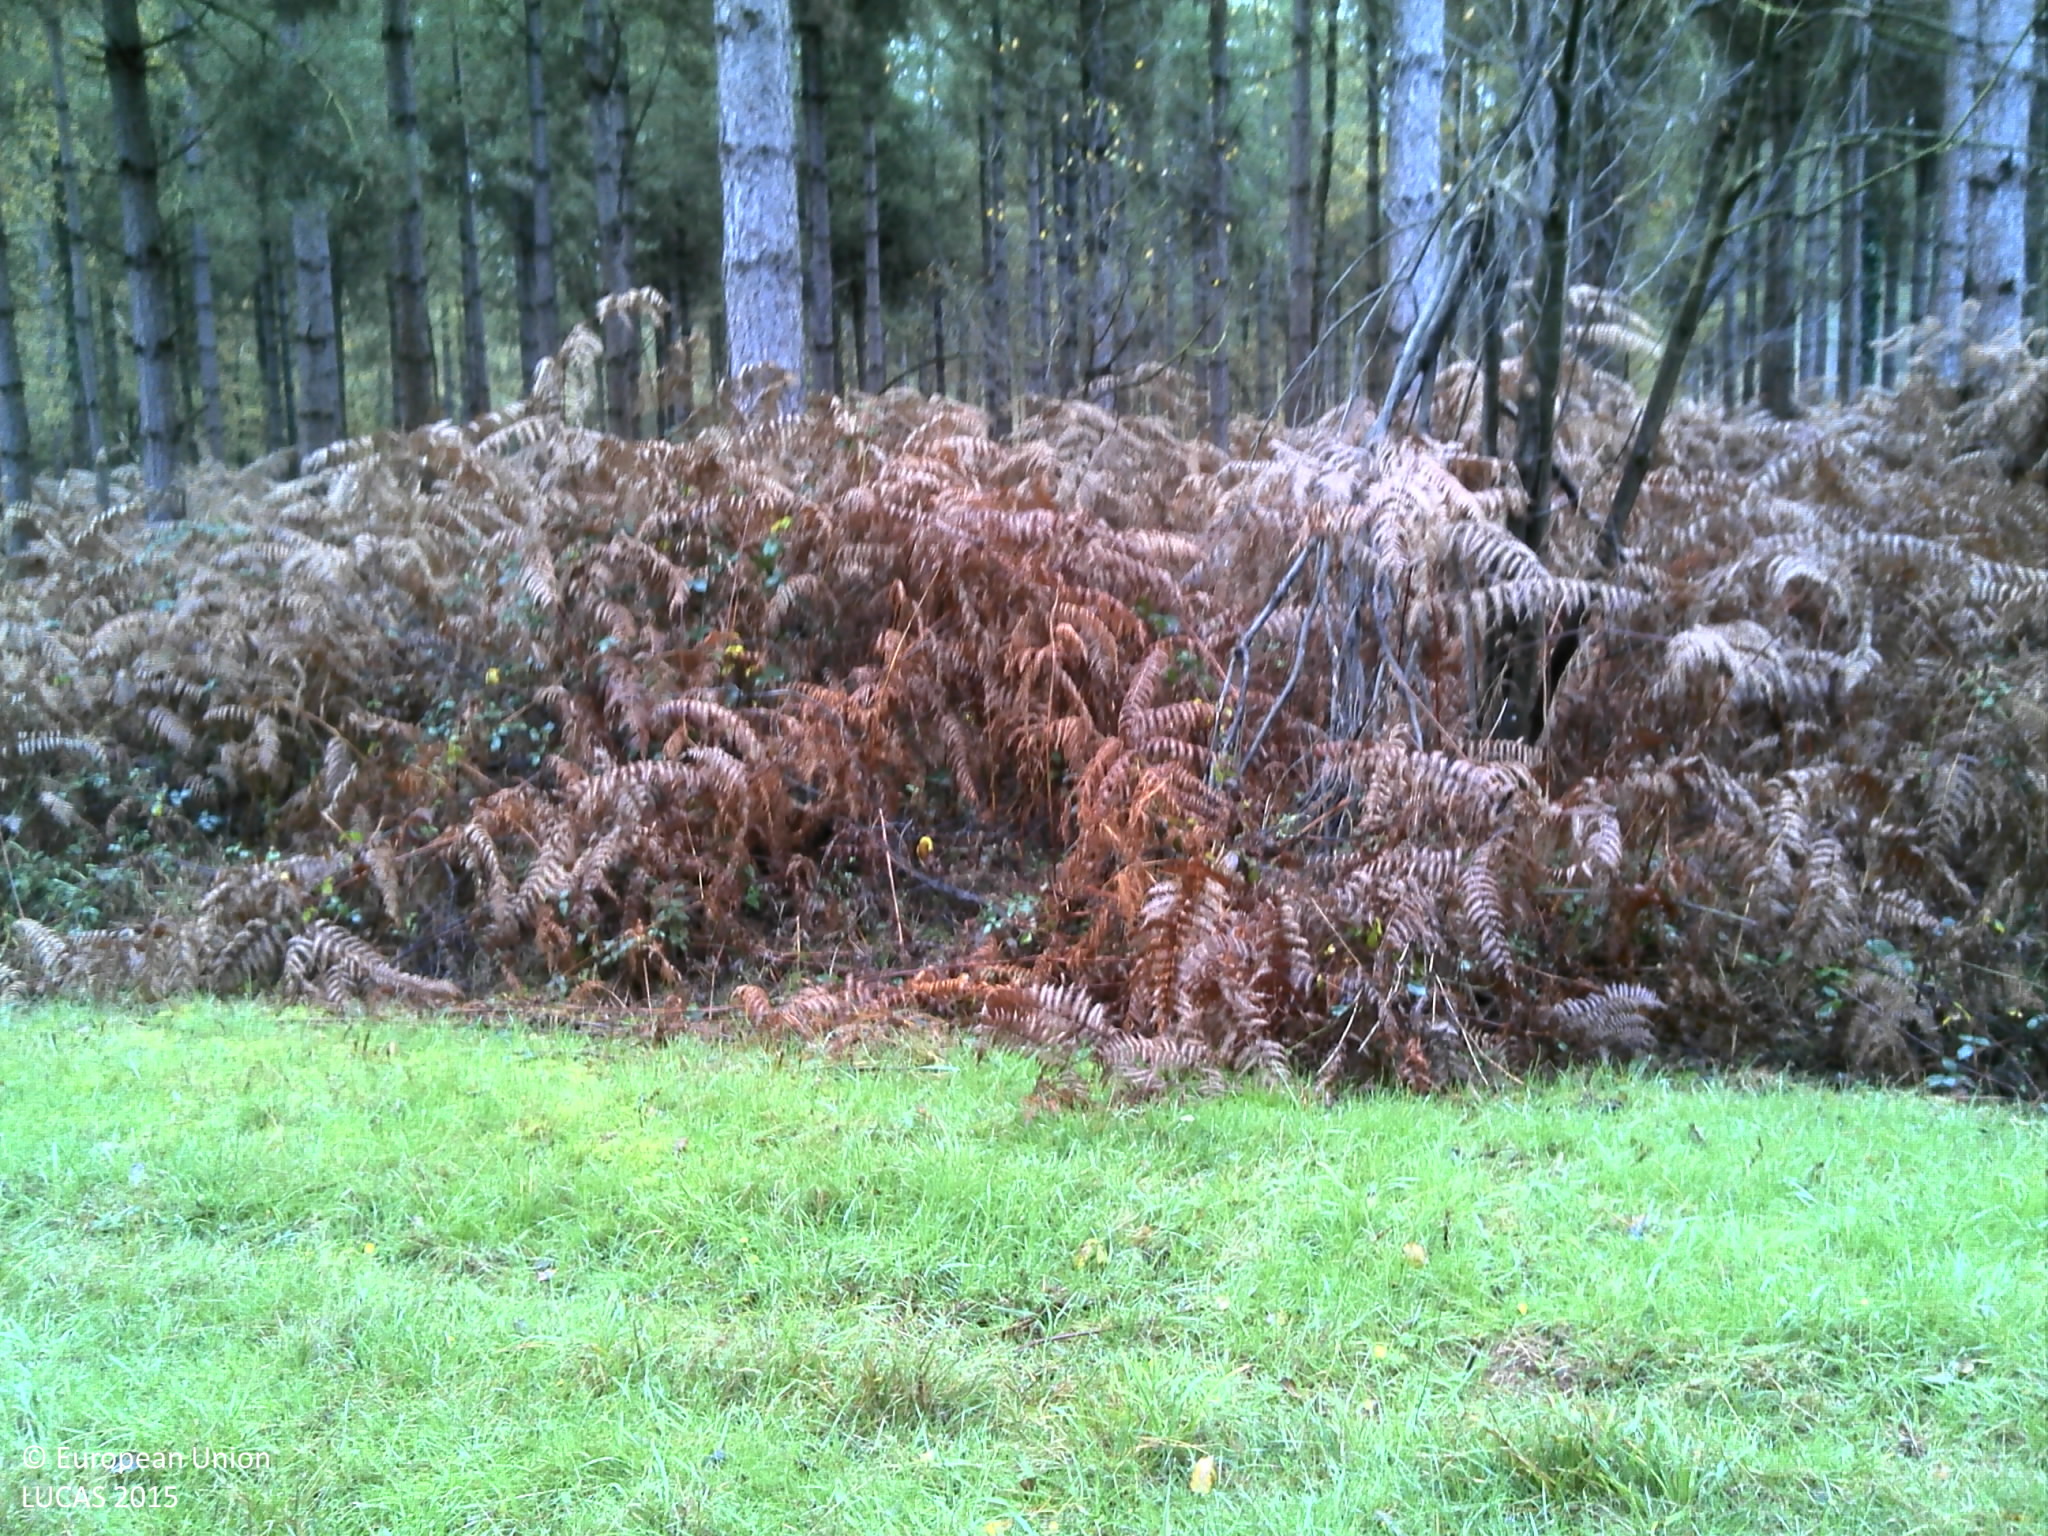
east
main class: Woodland
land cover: Pine dominated coniferous woodland
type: exotic forest
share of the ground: > 75 %
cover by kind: coniferous forest trees 85 %, herbaceous plants 15 %
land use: Forestry
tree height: > 5 m
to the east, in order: Pine dominated coniferous woodland; Grassland without tree/shrub cover; Pine dominated coniferous woodland; Grass margins; Broadleaved woodland
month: November
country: FR
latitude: 47.6878
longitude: -1.5417
